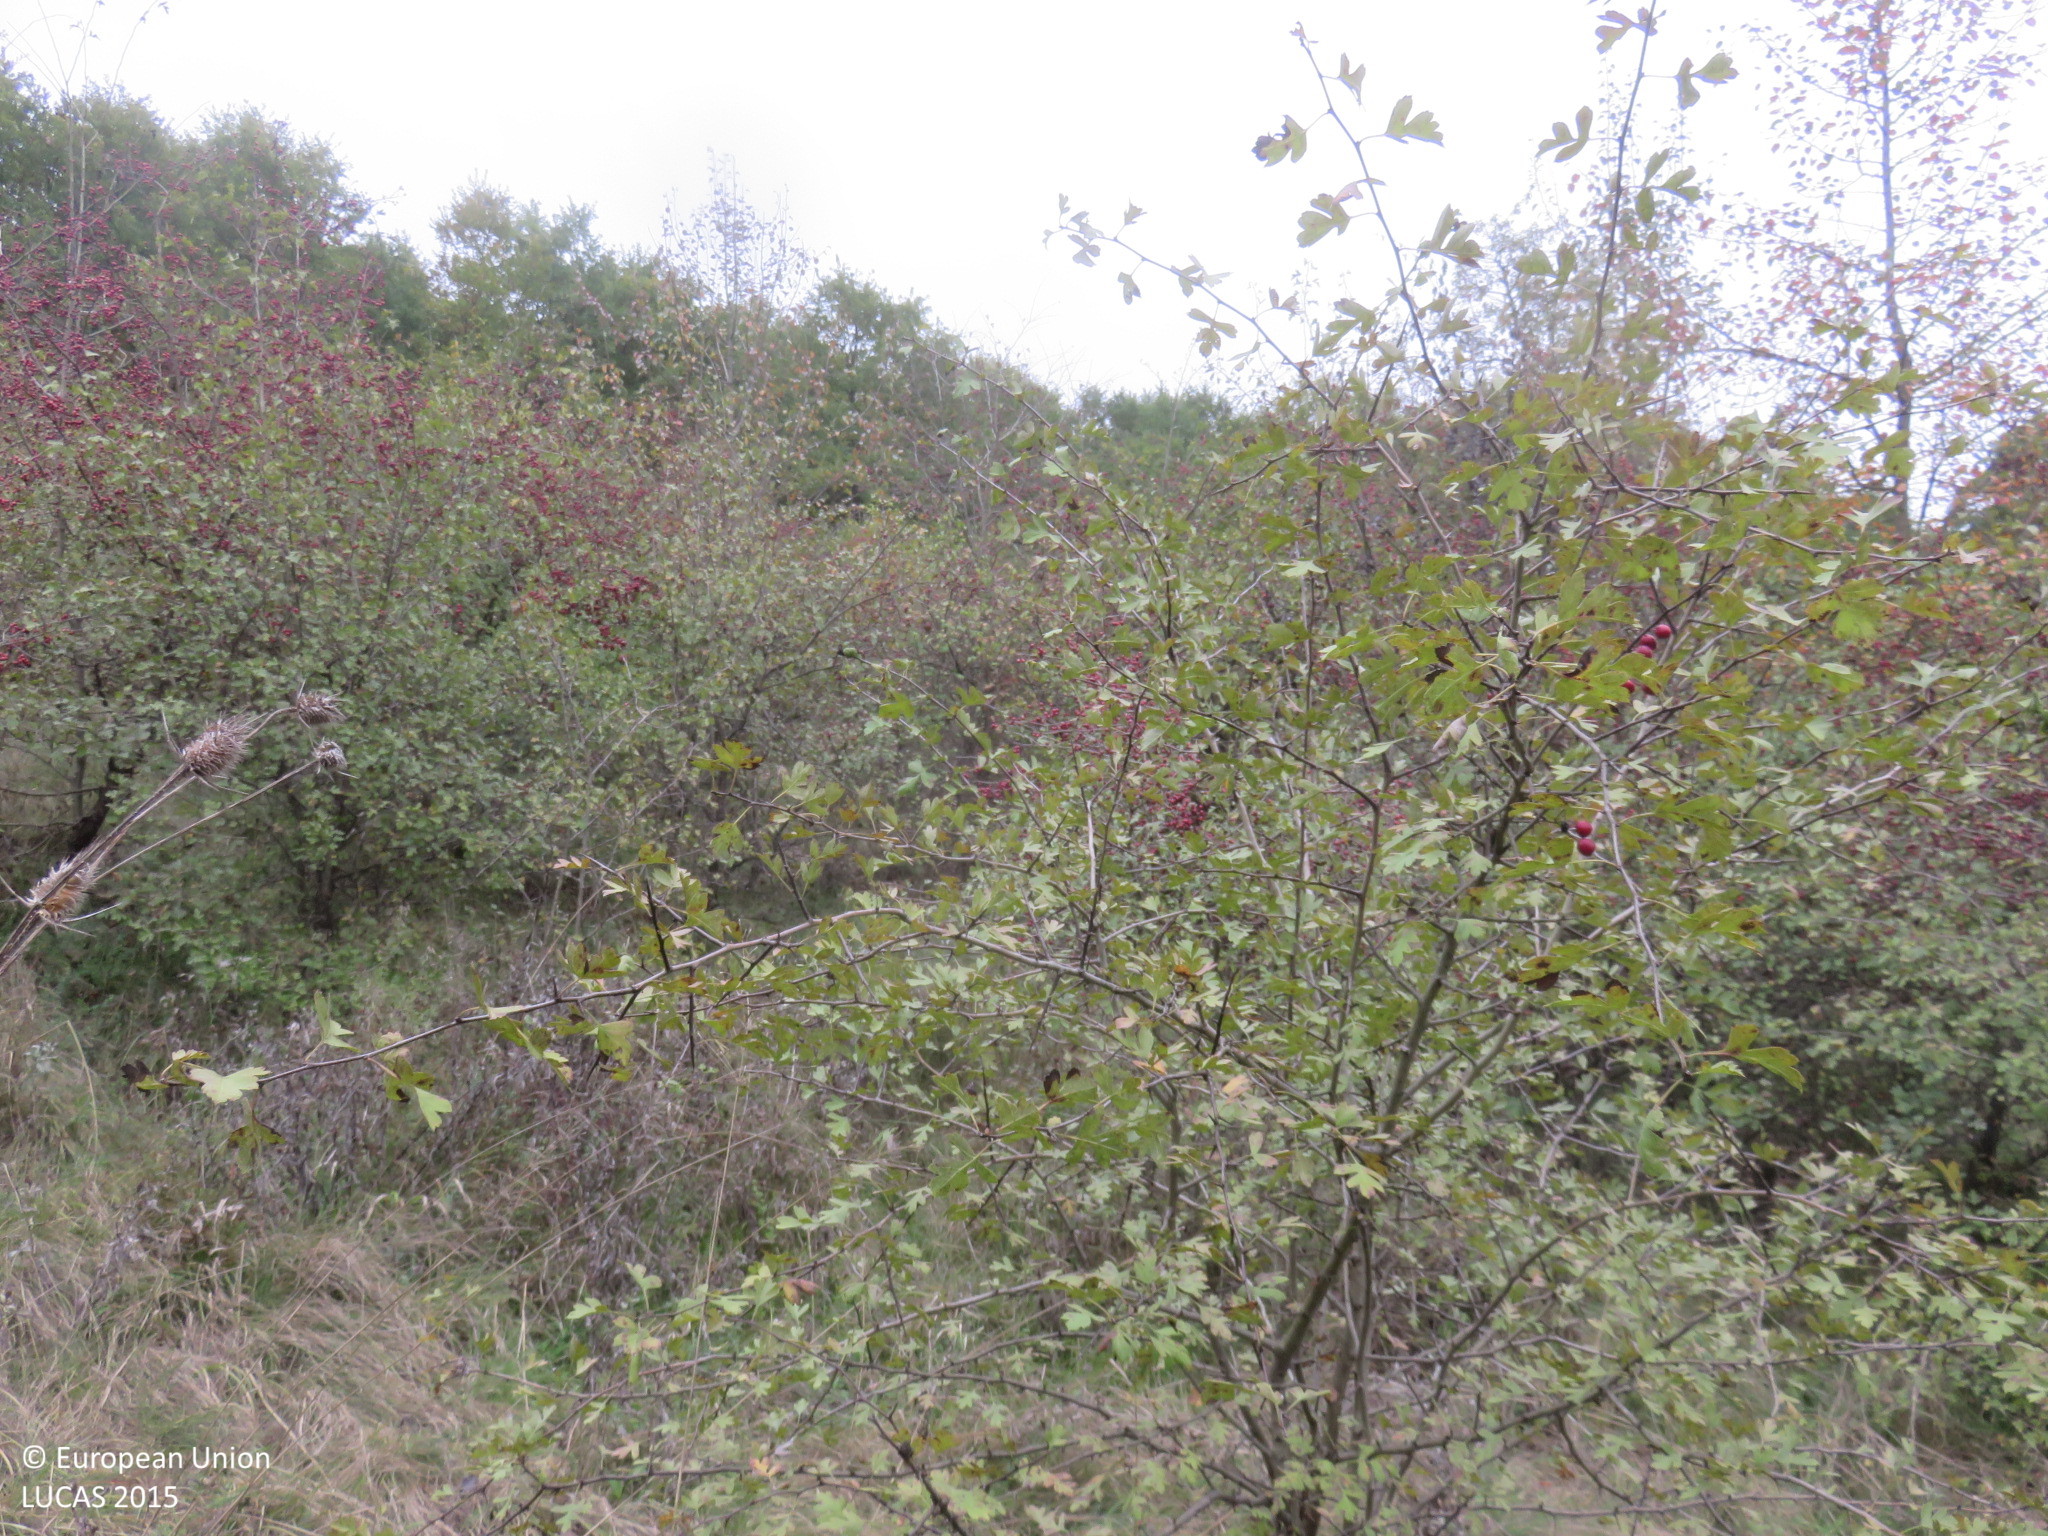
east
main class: Shrubland
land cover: Shrubland with sparse tree cover
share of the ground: > 75 %
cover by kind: shrubs 90 %, broadleaved forest trees 5 %, herbaceous plants 5 %
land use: Semi-natural and natural areas not in use
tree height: < 5 m
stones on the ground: < 10 %
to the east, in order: Shrubland with sparse tree cover; Tracks; Broadleaved woodland
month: October
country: BG
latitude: 43.0353
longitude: 25.2289
